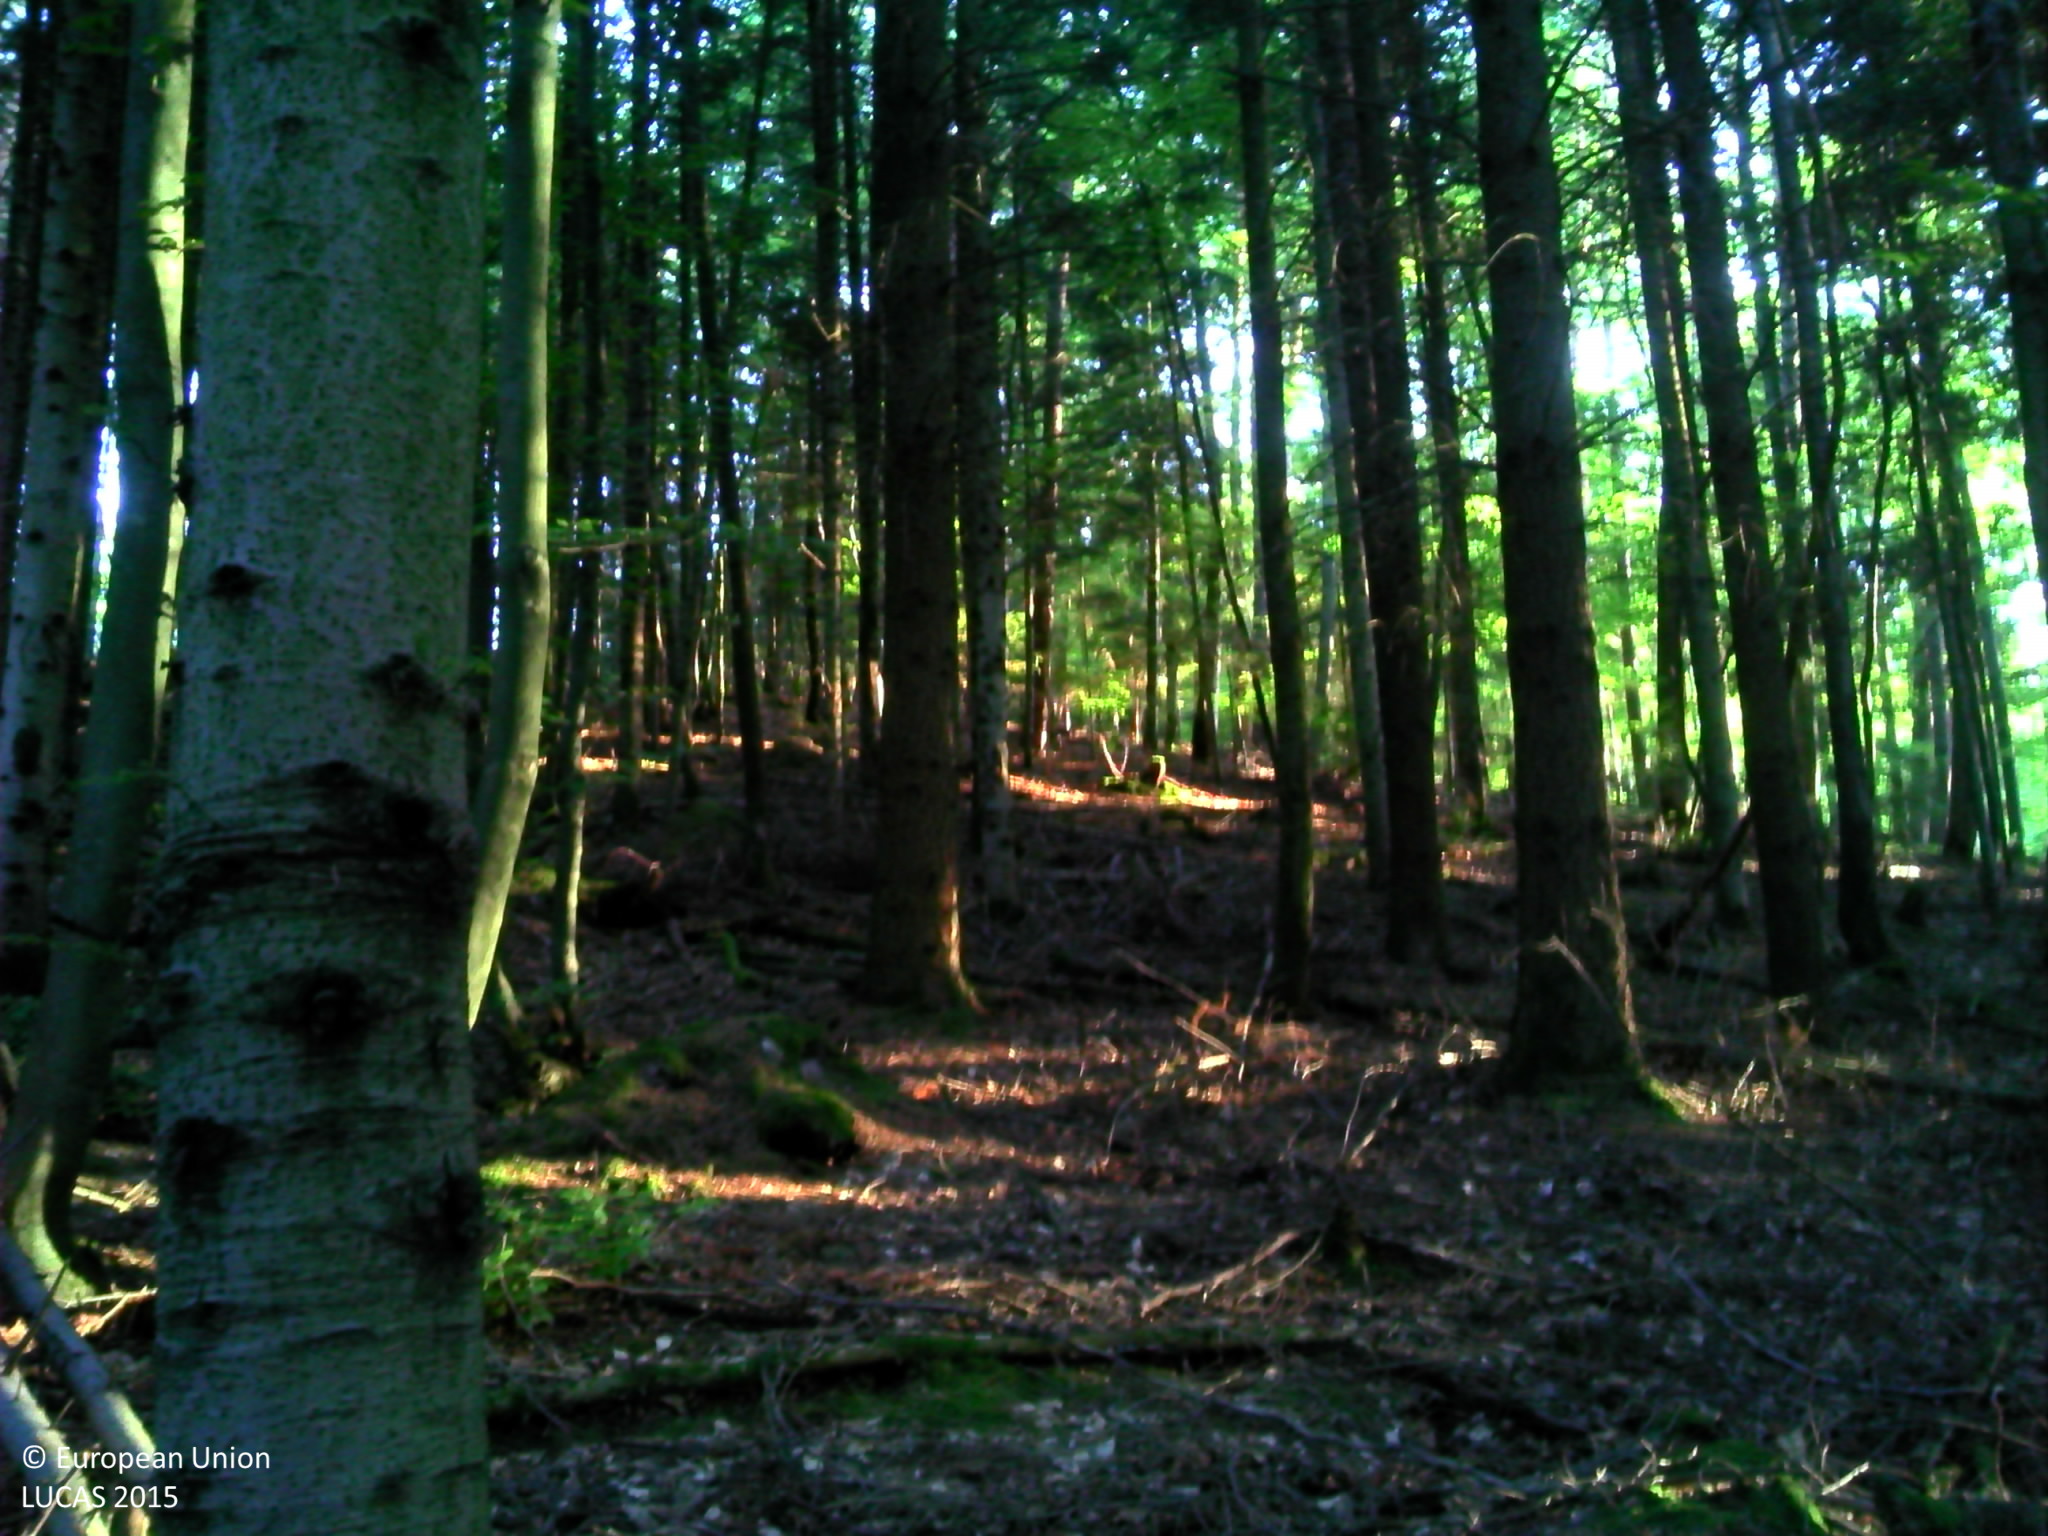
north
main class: Woodland
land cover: Spruce dominated coniferous woodland
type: hemiboreal forest and nemoral coniferous forest and mixed broadleaved-coniferous forest
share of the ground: > 75 %
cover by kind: coniferous forest trees 90 %, broadleaved forest trees 10 %
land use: Forestry
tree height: > 5 m
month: August
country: FR
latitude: 48.3536
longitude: 7.3424
